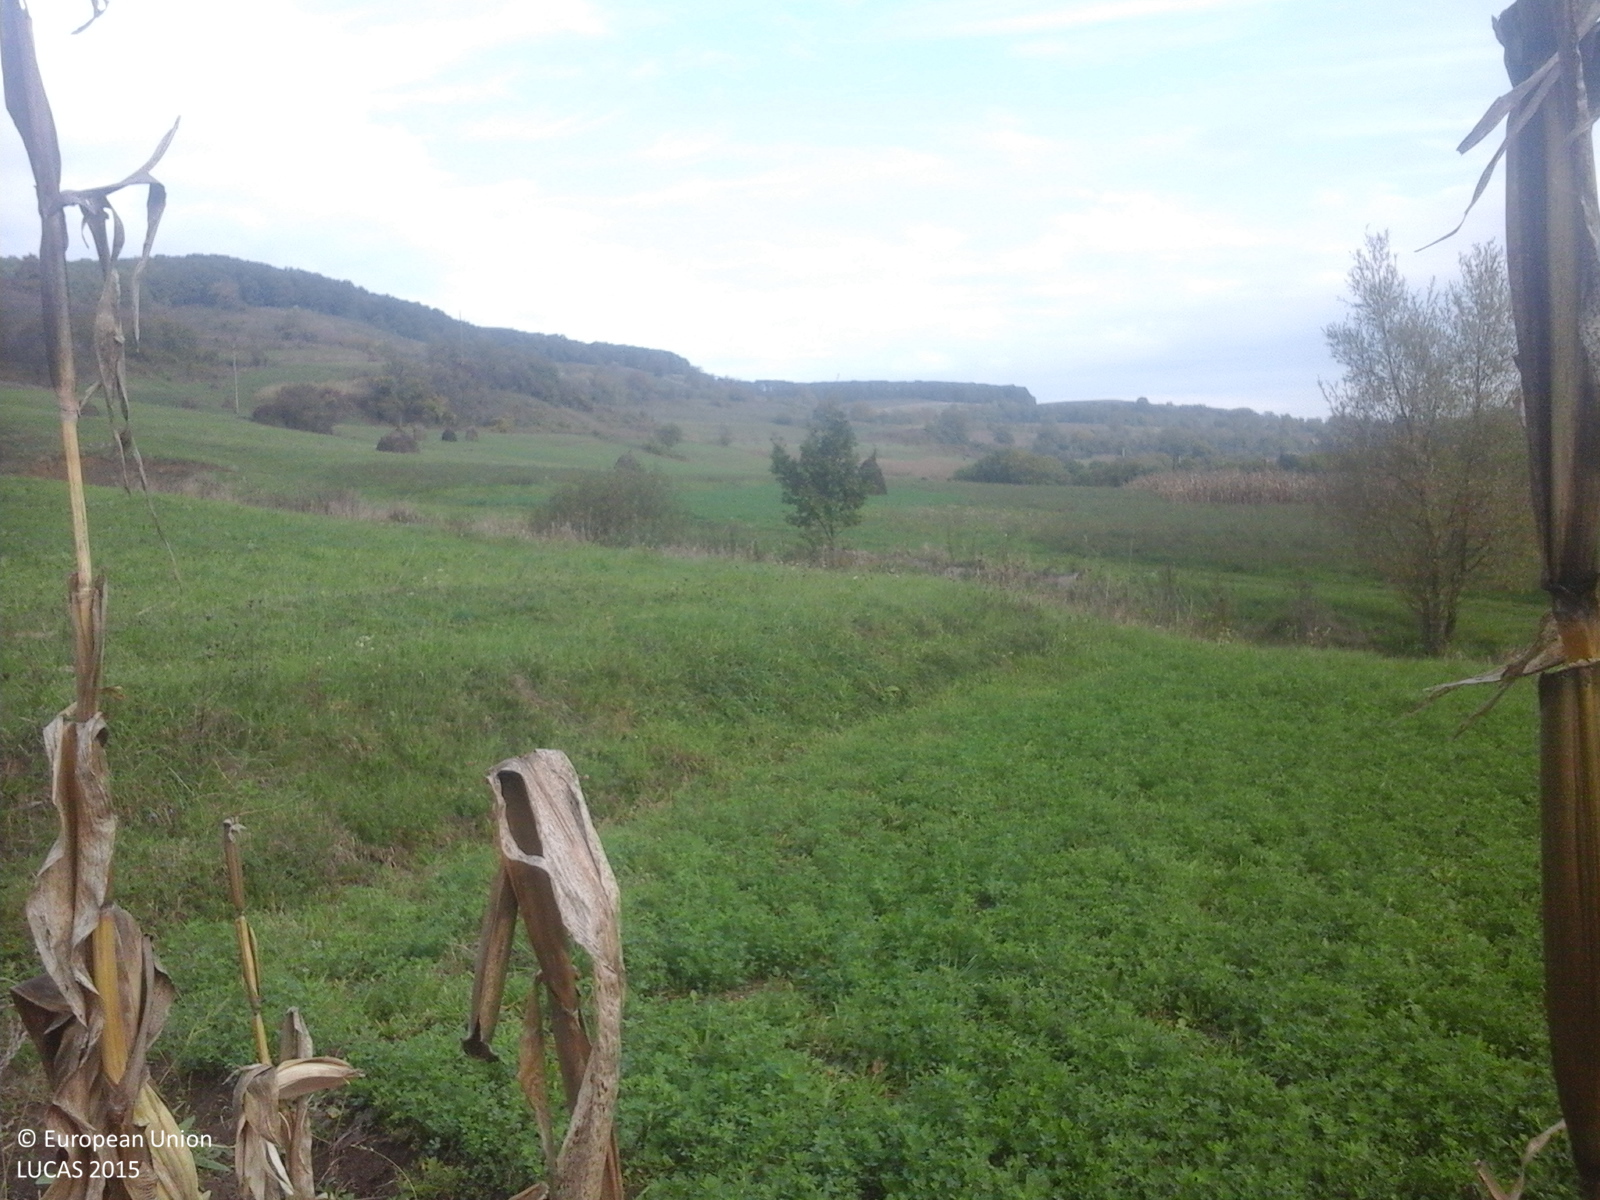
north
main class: Cropland
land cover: Maize
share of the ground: > 75 %
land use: Agriculture (excluding fallow land and kitchen gardens)
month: October
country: RO
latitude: 46.4997
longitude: 24.8309
